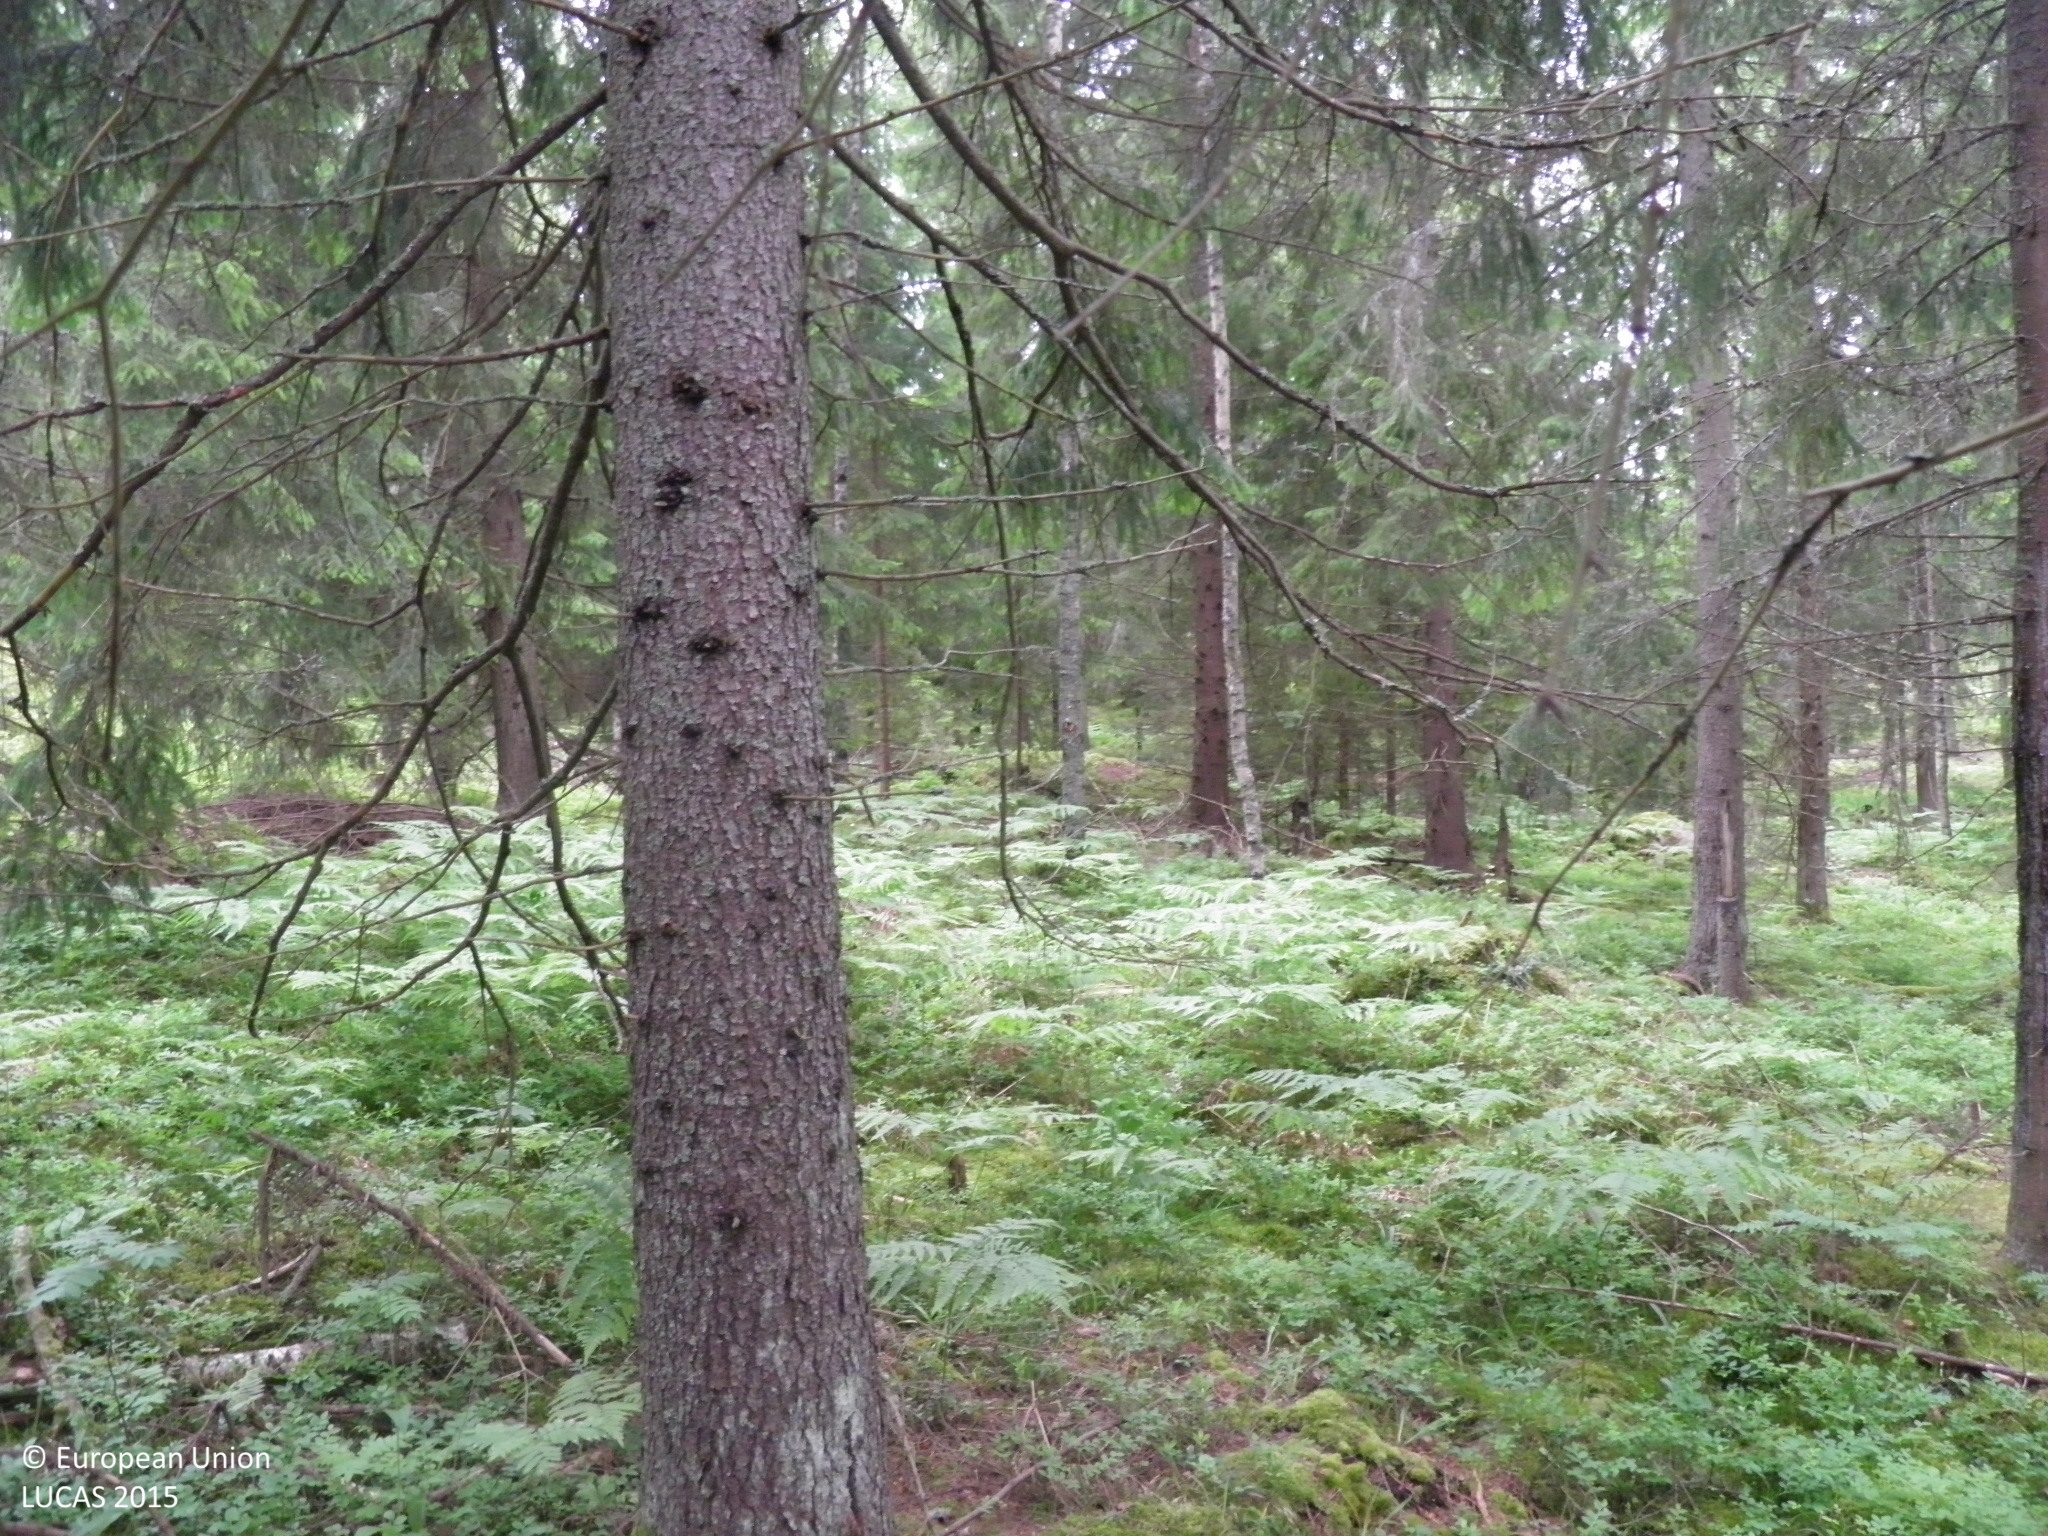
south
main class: Woodland
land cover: Spruce dominated coniferous woodland
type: hemiboreal forest and nemoral coniferous forest and mixed broadleaved-coniferous forest
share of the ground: > 75 %
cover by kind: coniferous forest trees 70 %, broadleaved forest trees 10 %, herbaceous plants 10 %, shrubs 5 %, lichens and mosses 5 %
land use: Forestry
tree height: > 5 m
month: June
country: FI
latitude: 60.2725
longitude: 22.1616
